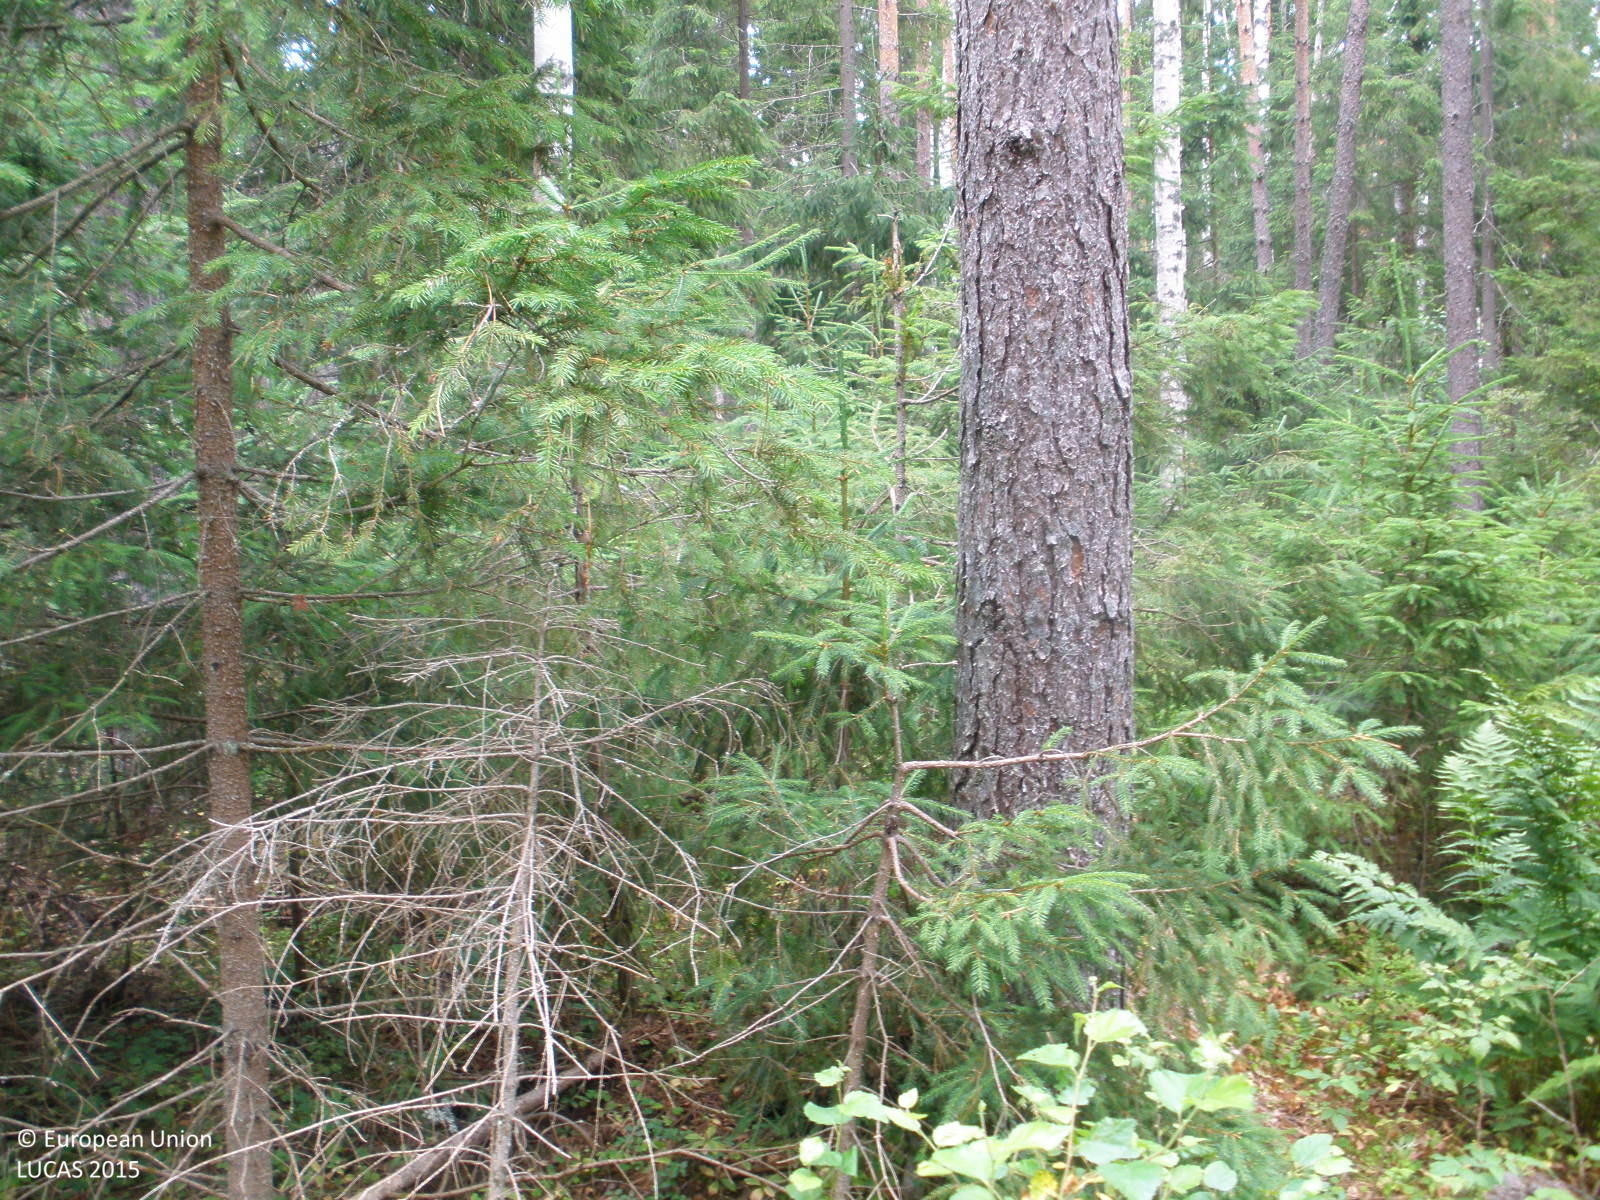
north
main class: Woodland
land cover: Pine dominated coniferous woodland
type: boreal forest
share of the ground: > 75 %
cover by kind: coniferous forest trees 70 %, herbaceous plants 15 %, shrubs 10 %, broadleaved forest trees 5 %
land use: Forestry
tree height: > 5 m
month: July
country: FI
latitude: 61.4121
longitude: 24.4675
